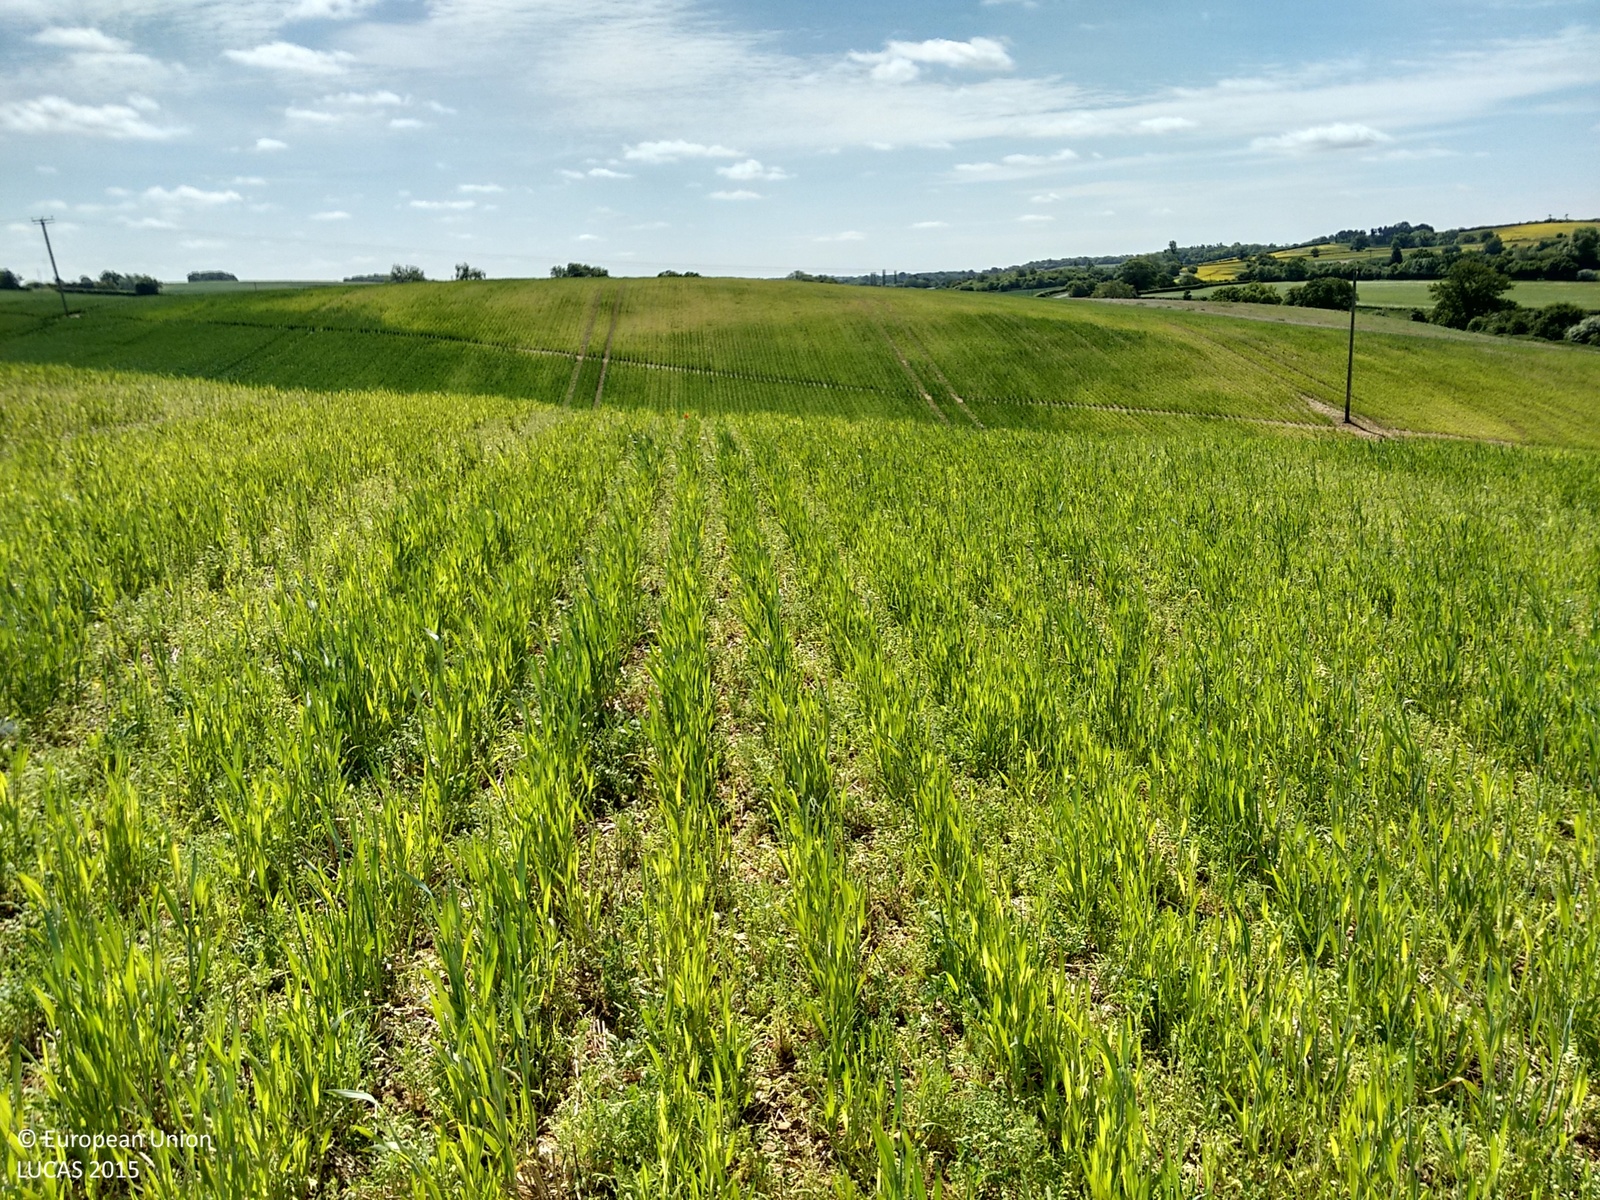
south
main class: Cropland
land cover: Common wheat
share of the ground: > 75 %
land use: Agriculture (excluding fallow land and kitchen gardens)
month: May
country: GB
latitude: 51.9140
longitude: -0.2557
